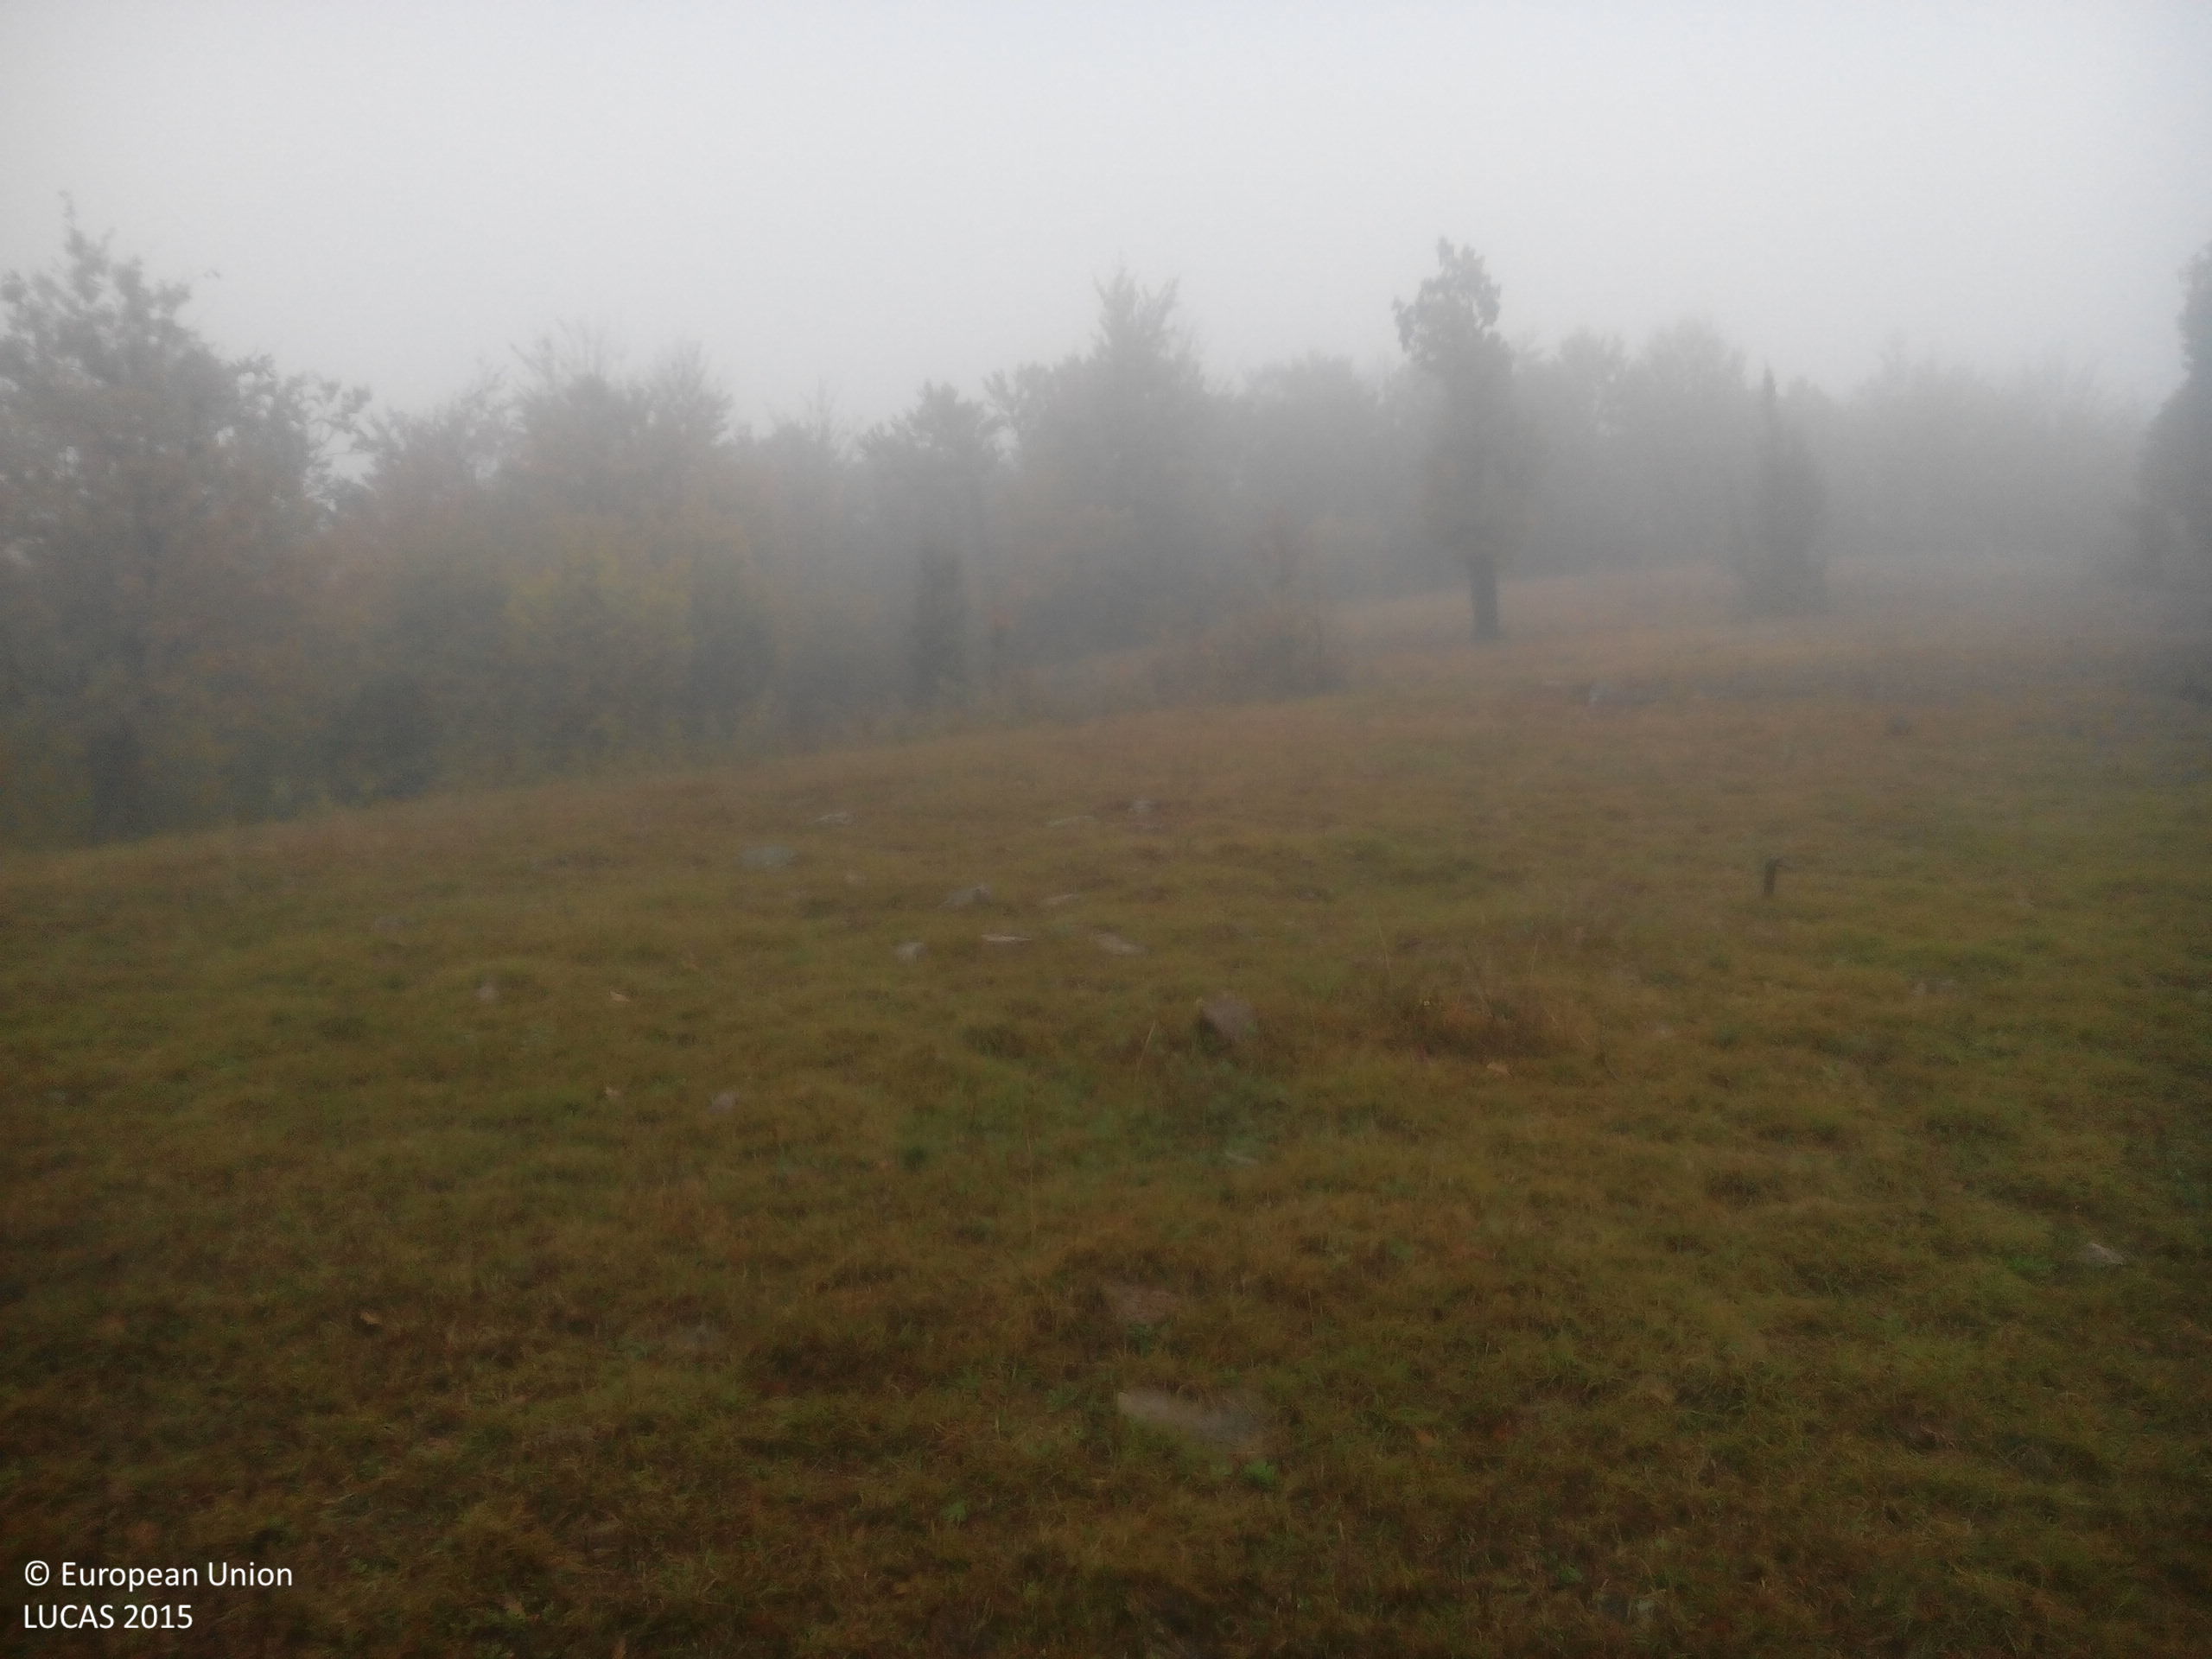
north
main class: Grassland
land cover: Grassland with sparse tree/shrub cover
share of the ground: > 75 %
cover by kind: herbaceous plants 90 %, broadleaved forest trees 5 %, shrubs 5 %
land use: Agriculture (excluding fallow land and kitchen gardens)
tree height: > 5 m
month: October
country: BG
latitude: 42.9716
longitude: 24.2875
